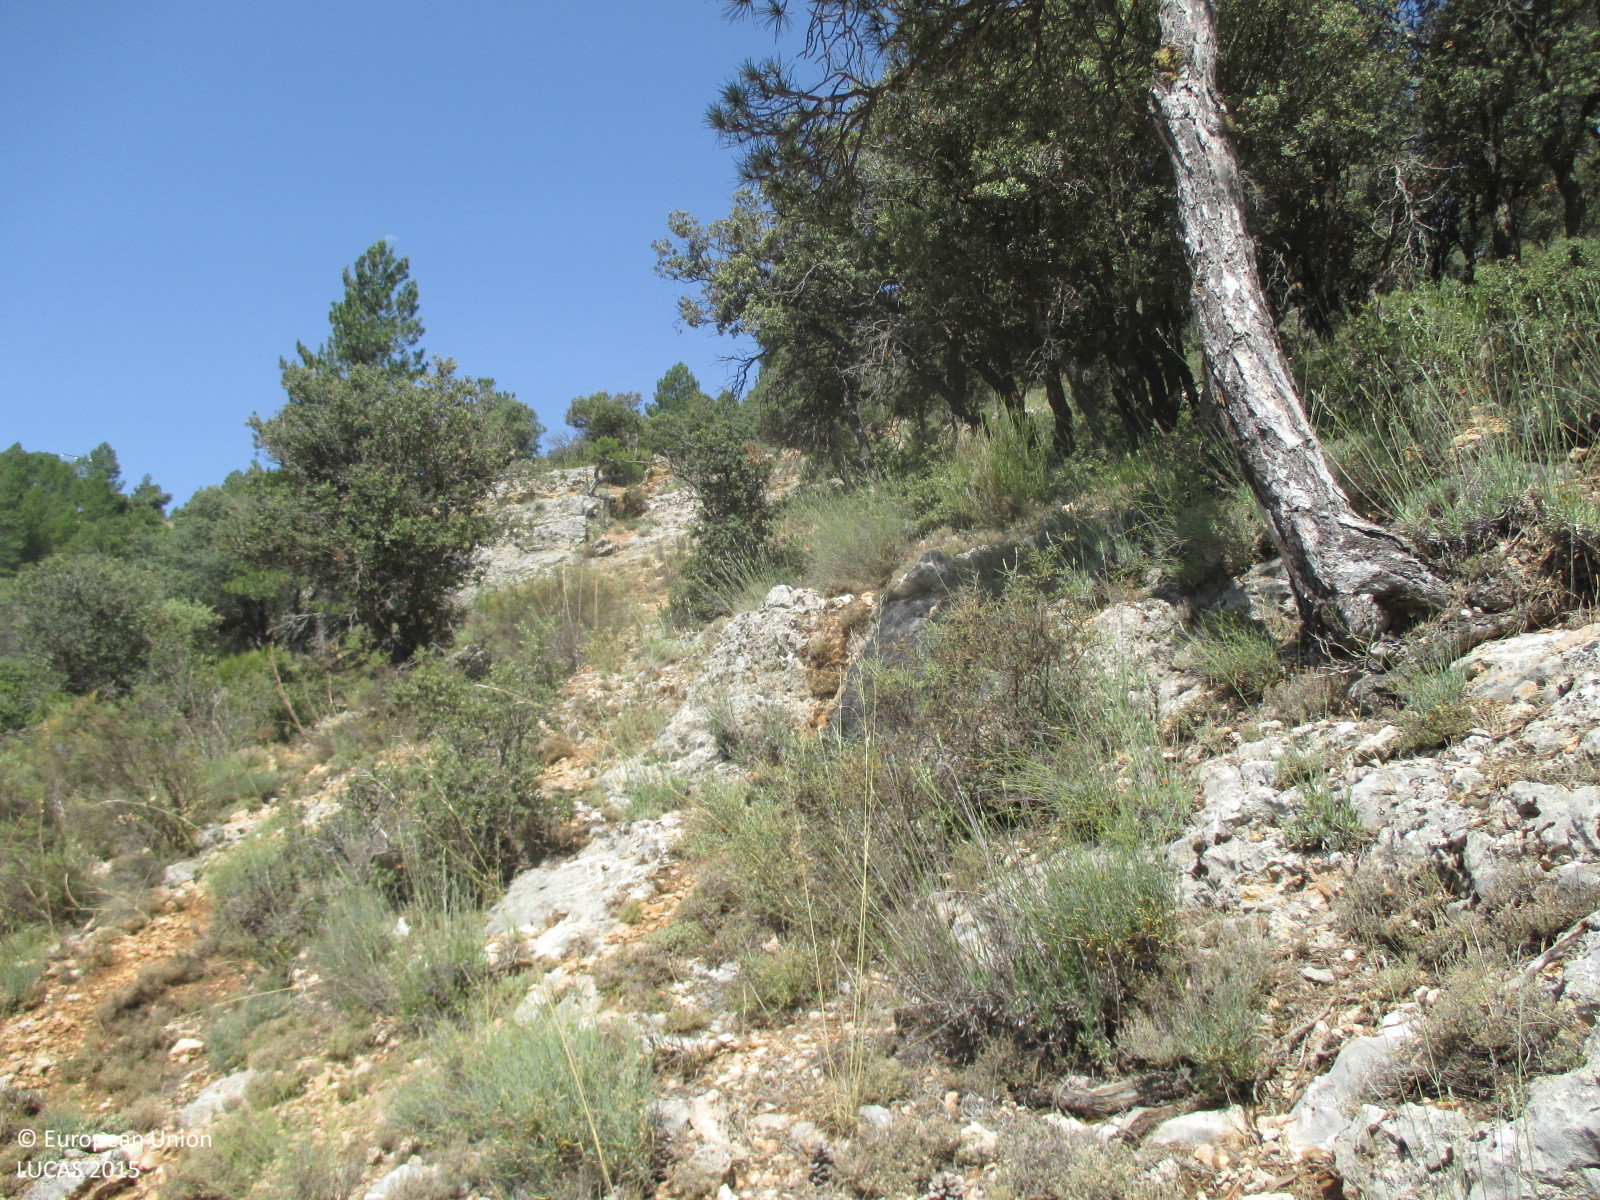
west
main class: Woodland
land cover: Pine dominated mixed woodland
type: alpine coniferous forest
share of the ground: > 75 %
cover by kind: coniferous forest trees 60 %, broadleaved forest trees 30 %, consolidated bare surface 10 %
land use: Forestry
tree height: > 5 m
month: July
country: ES
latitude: 38.1155
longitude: -2.4602
